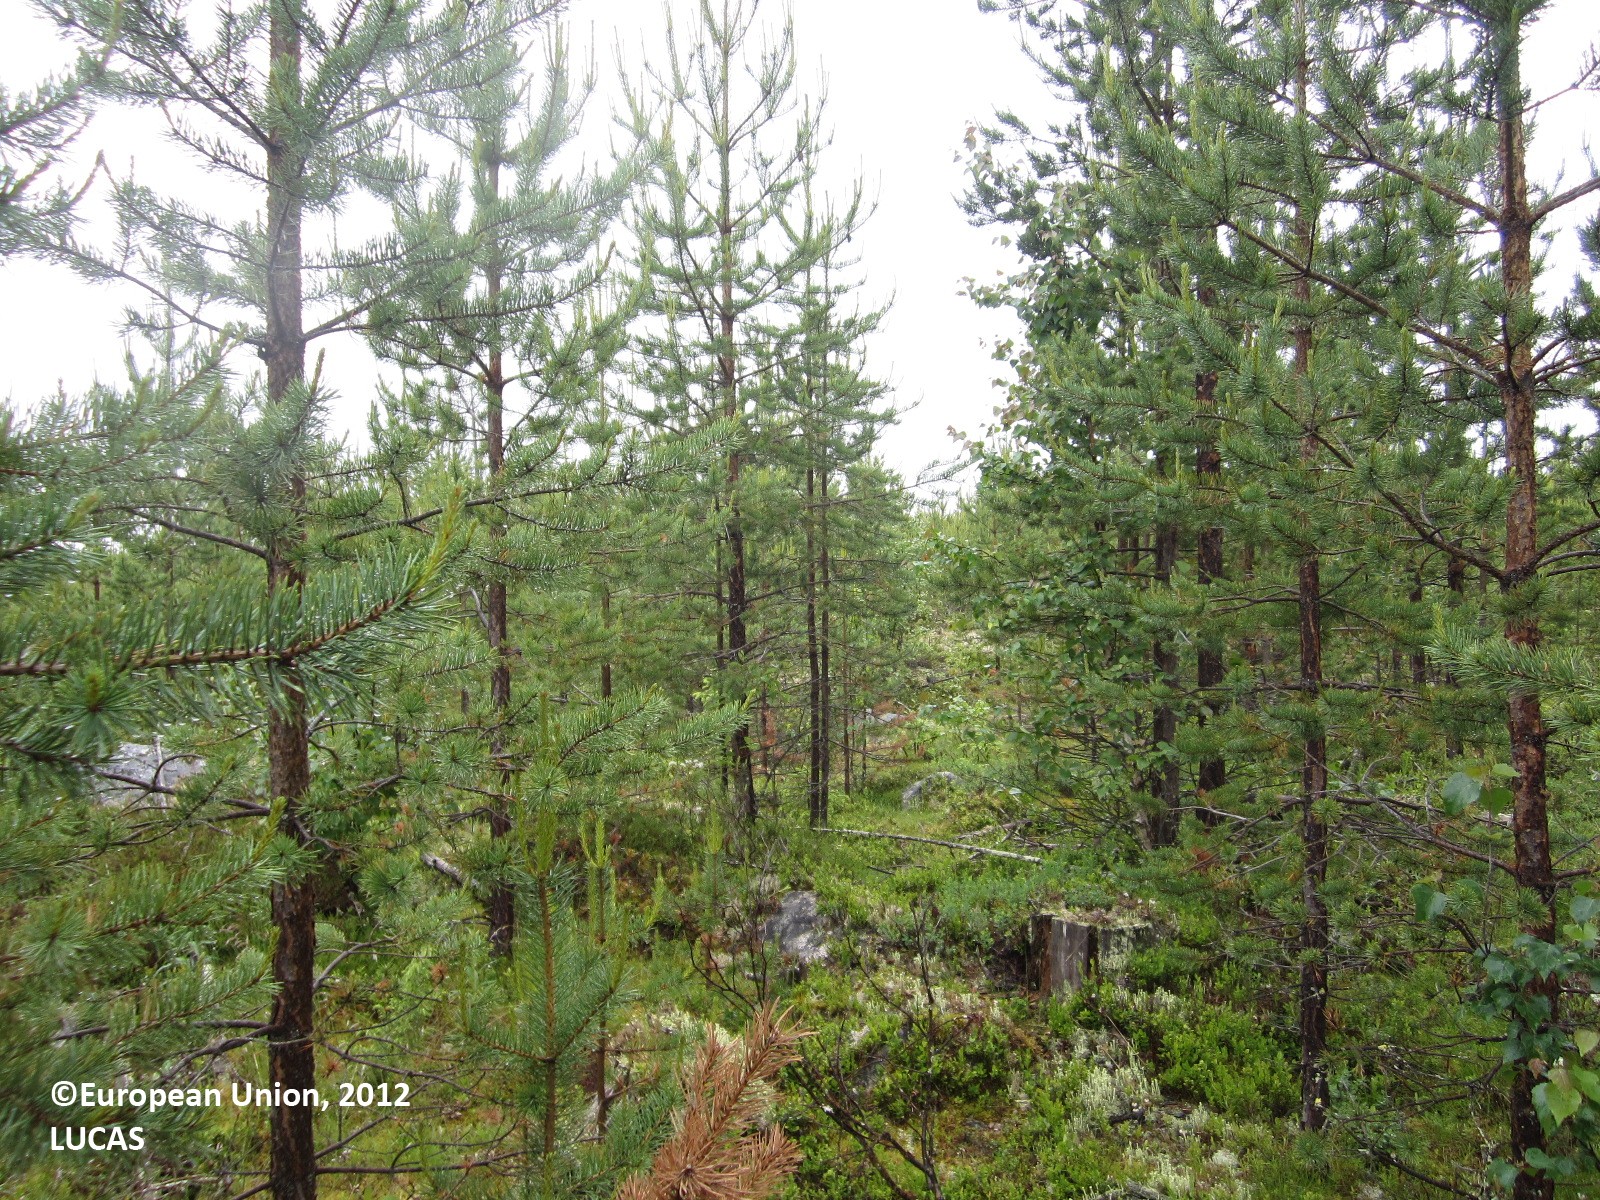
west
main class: Woodland
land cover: Pine dominated coniferous woodland
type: boreal forest
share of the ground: 50 - 75 %
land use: Forestry
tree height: < 5 m
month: June
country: FI
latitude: 64.5432
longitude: 29.8916
